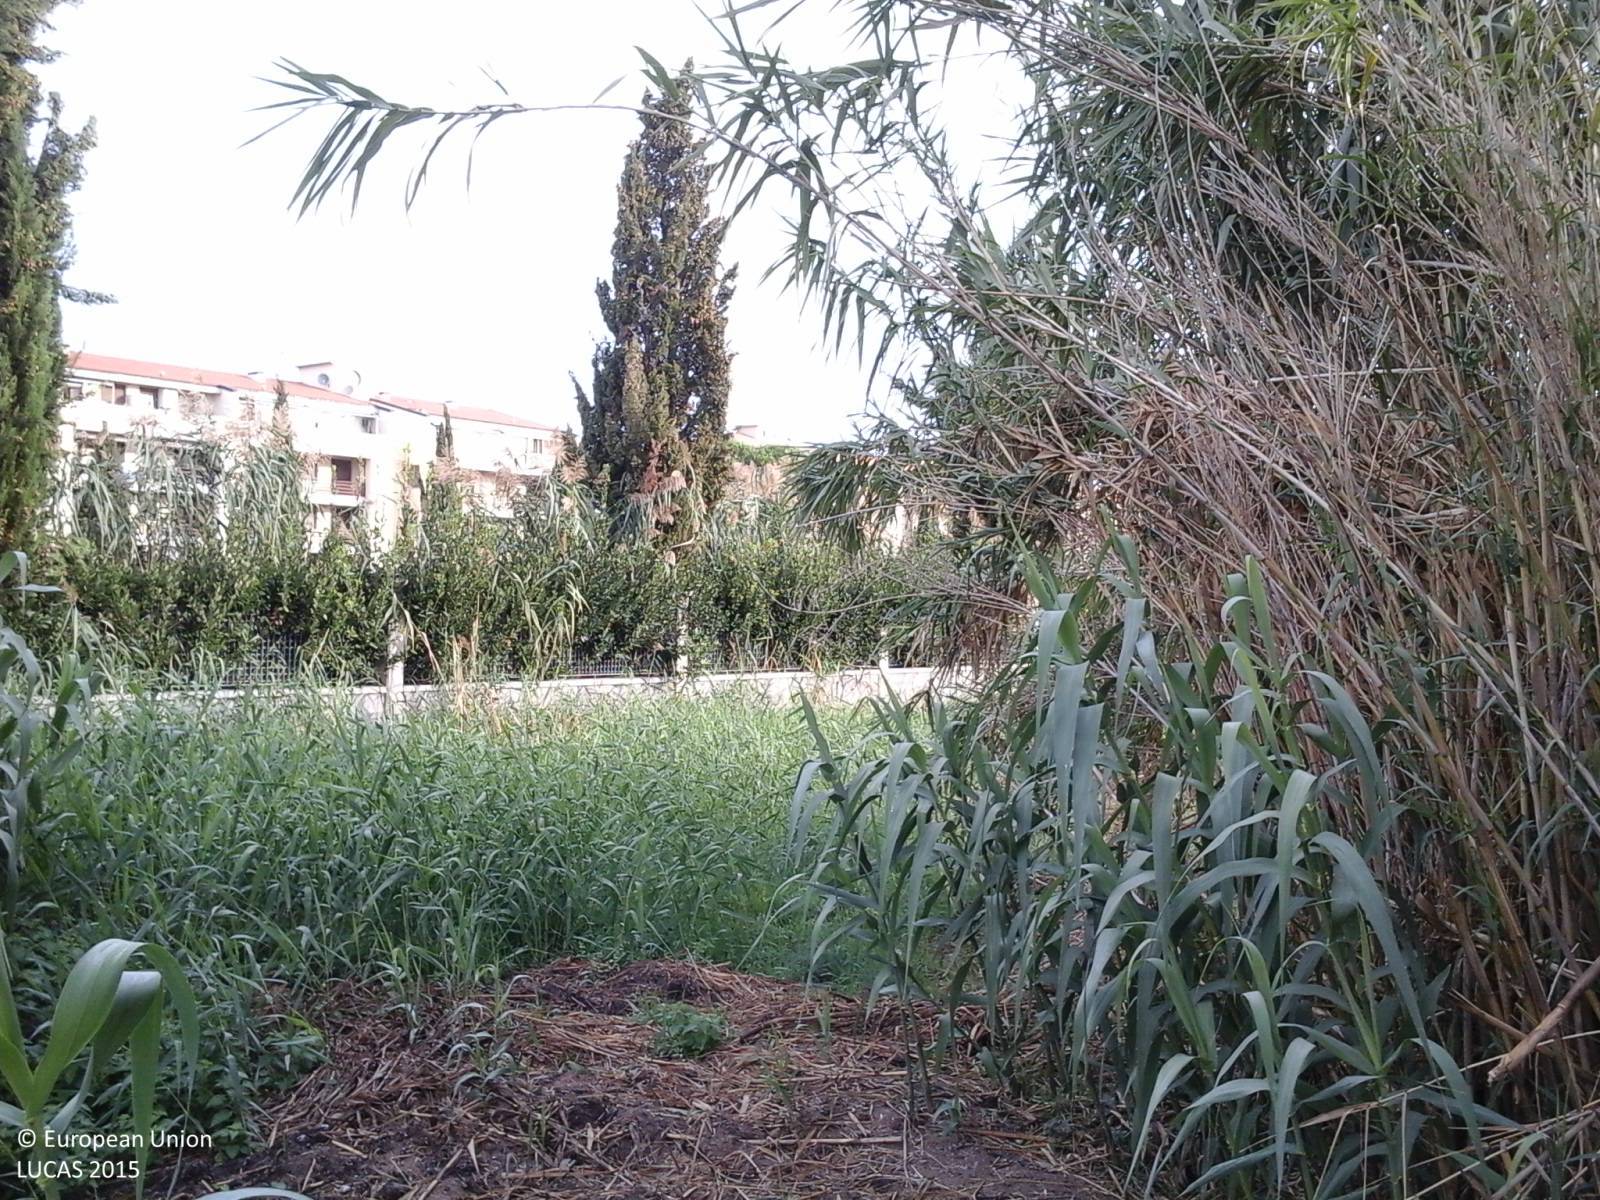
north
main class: Grassland
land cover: Grassland without tree/shrub cover
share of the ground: 25 - 50 %
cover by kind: herbaceous plants 100 %
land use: Semi-natural and natural areas not in use
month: October
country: IT
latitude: 43.3028
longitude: 10.5039
